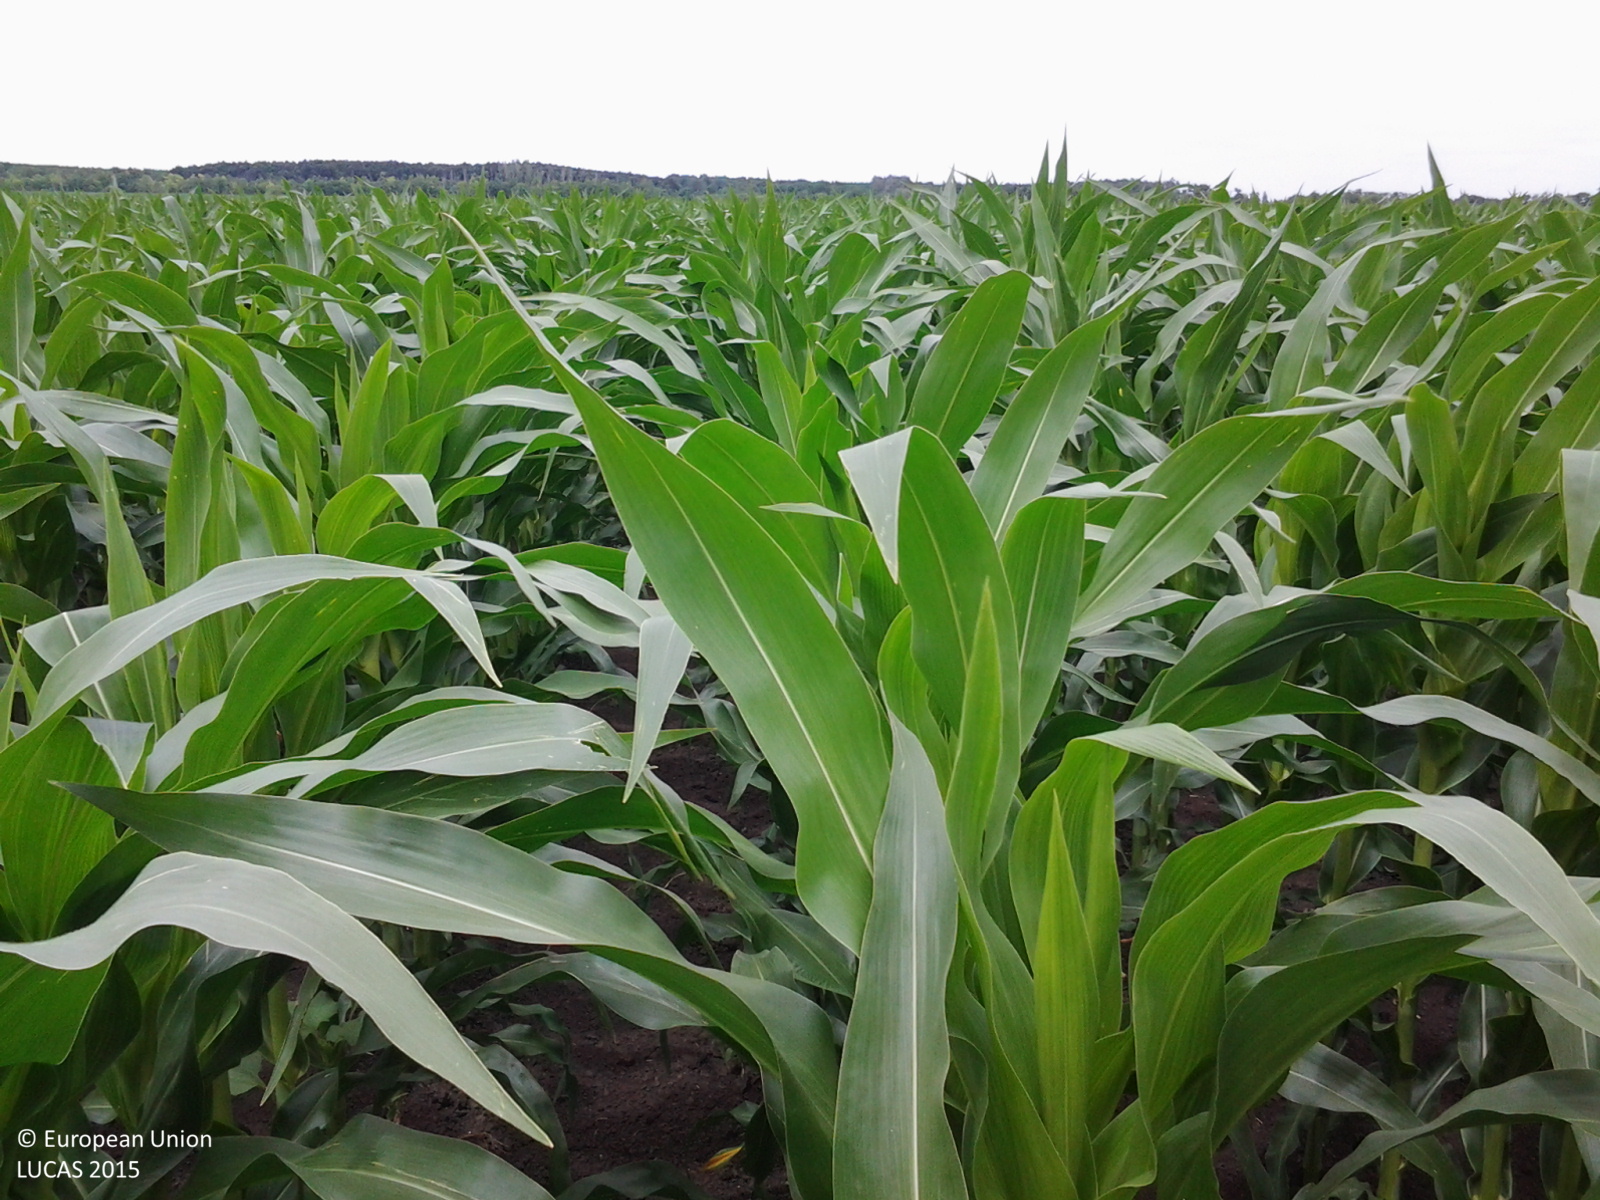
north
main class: Cropland
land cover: Maize
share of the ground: > 75 %
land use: Agriculture (excluding fallow land and kitchen gardens)
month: June
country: HU
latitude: 46.6479
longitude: 20.7040
